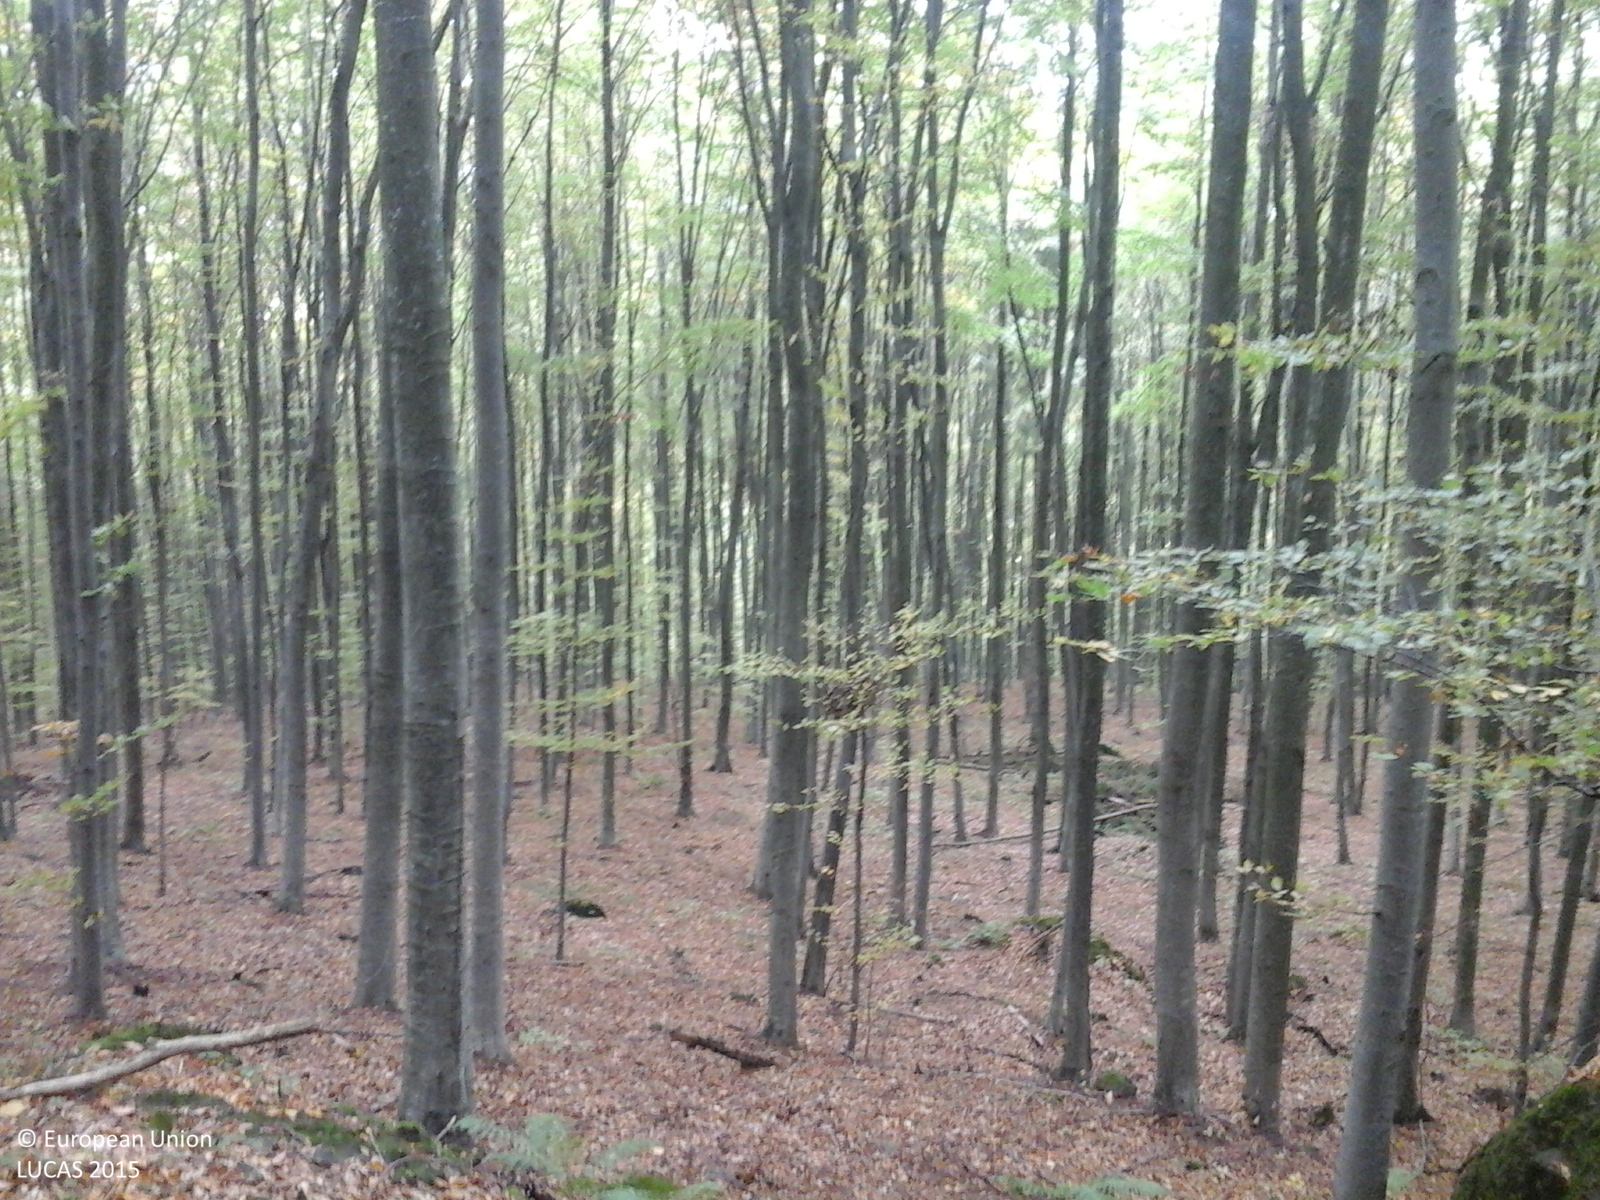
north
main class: Woodland
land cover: Broadleaved woodland
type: beech forest
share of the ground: > 75 %
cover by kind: broadleaved forest trees 100 %
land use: Forestry
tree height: > 5 m
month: October
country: RO
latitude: 46.6436
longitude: 24.9786
